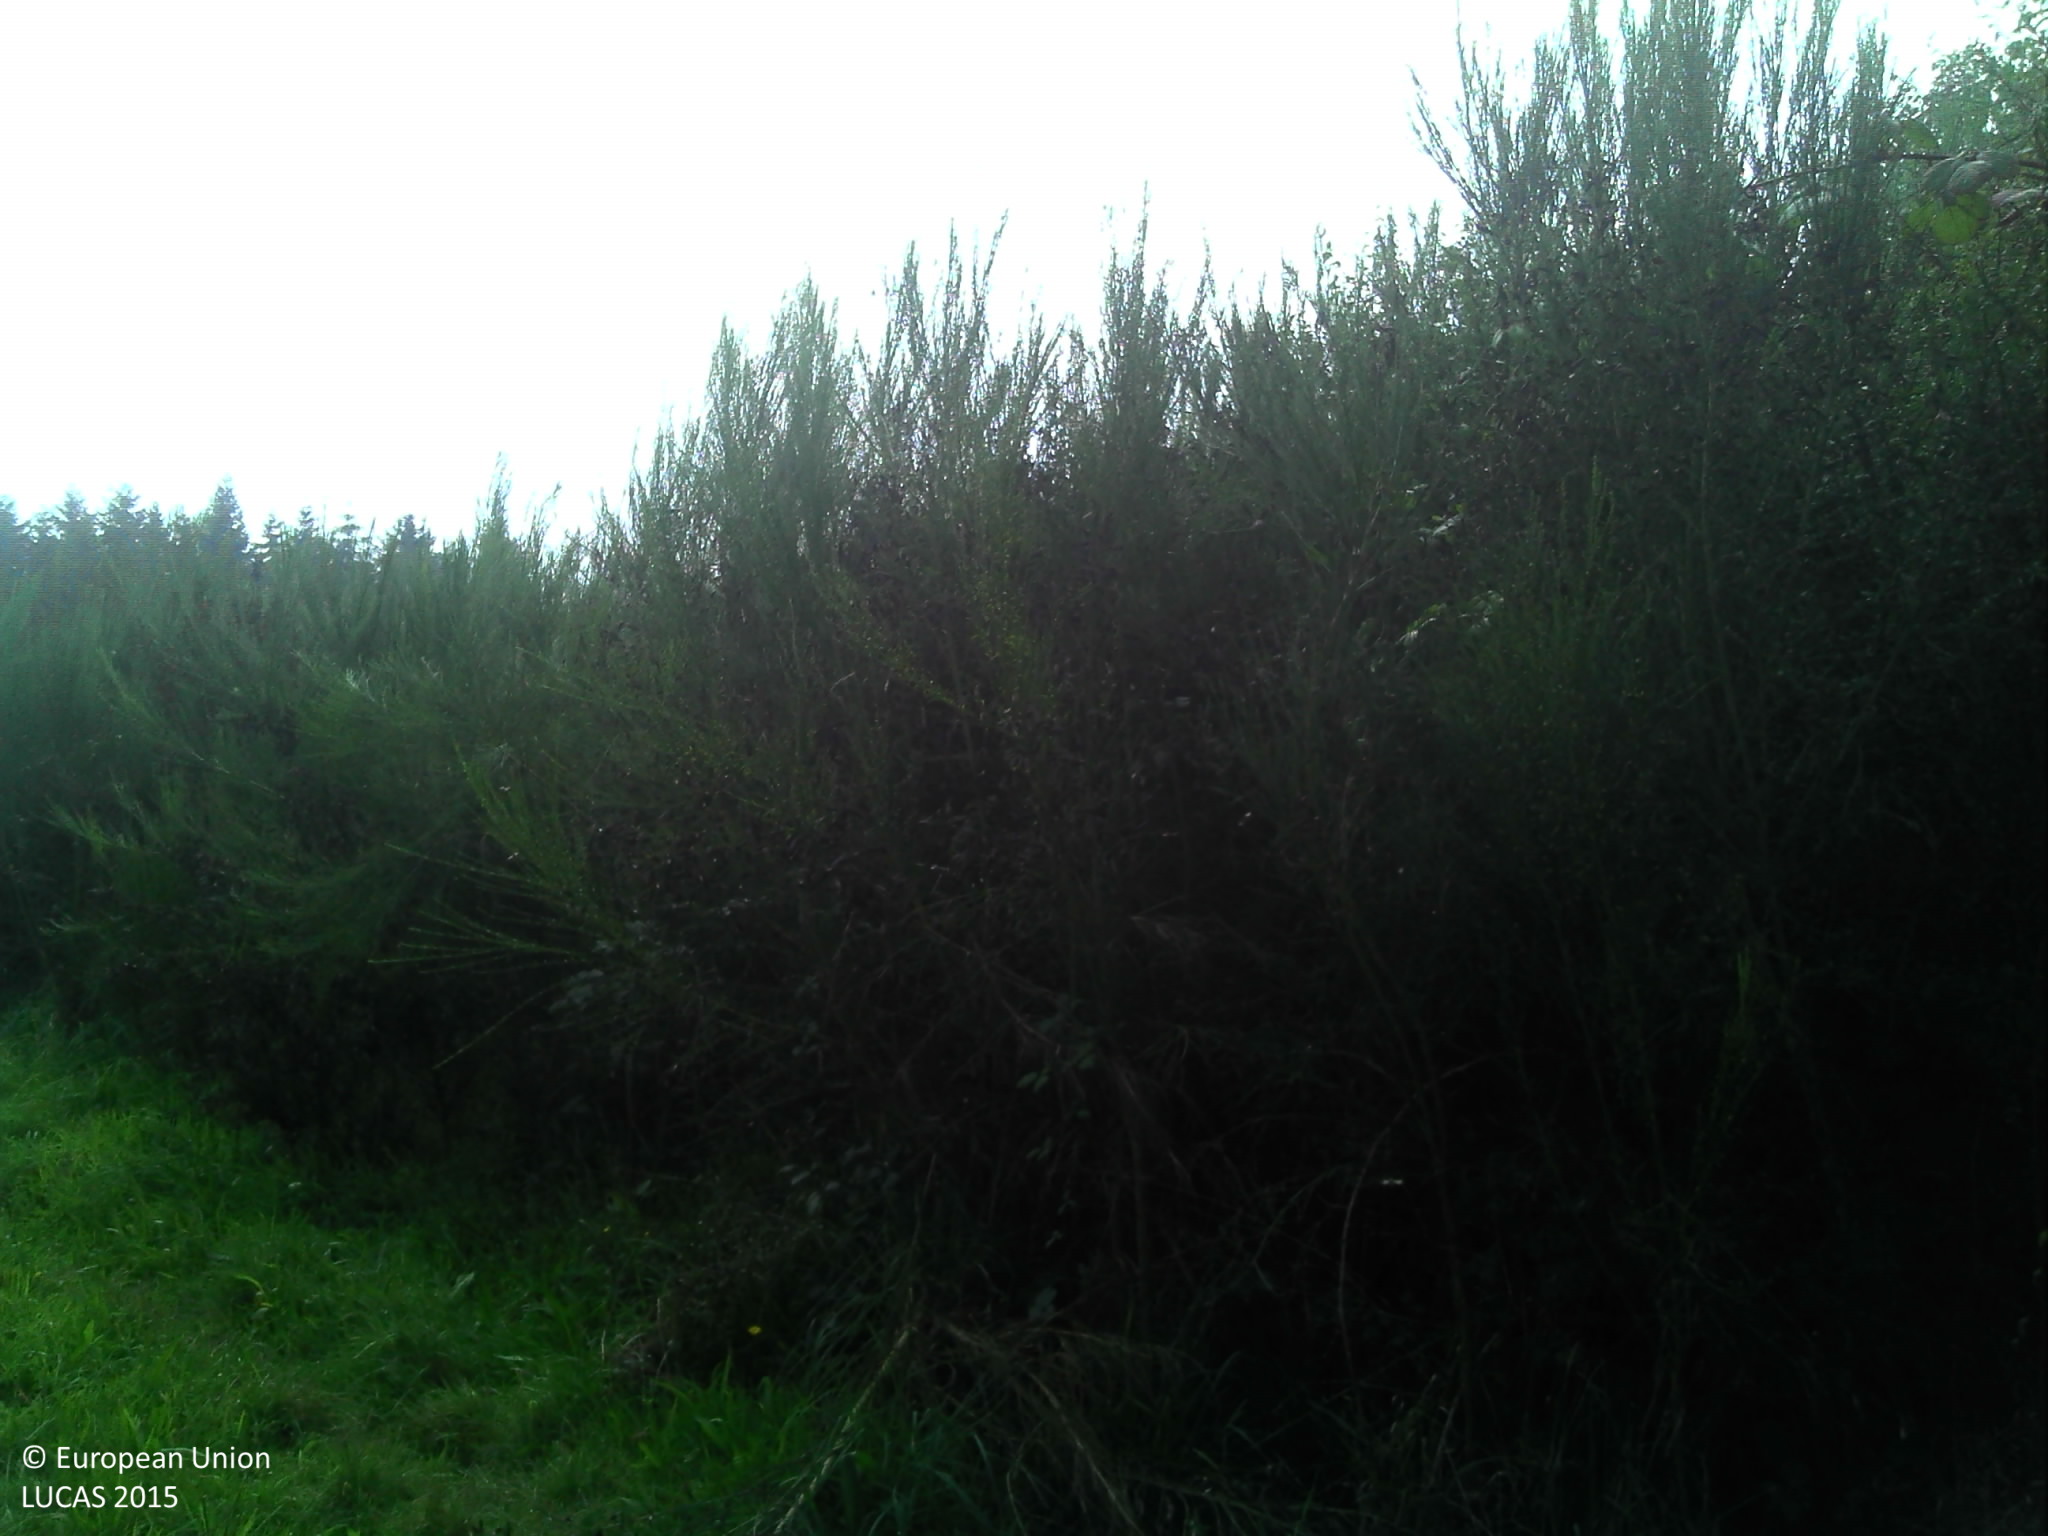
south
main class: Shrubland
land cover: Shrubland without tree cover
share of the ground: > 75 %
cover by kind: shrubs 100 %
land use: Semi-natural and natural areas not in use
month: October
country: FR
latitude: 48.5089
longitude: -3.1347
